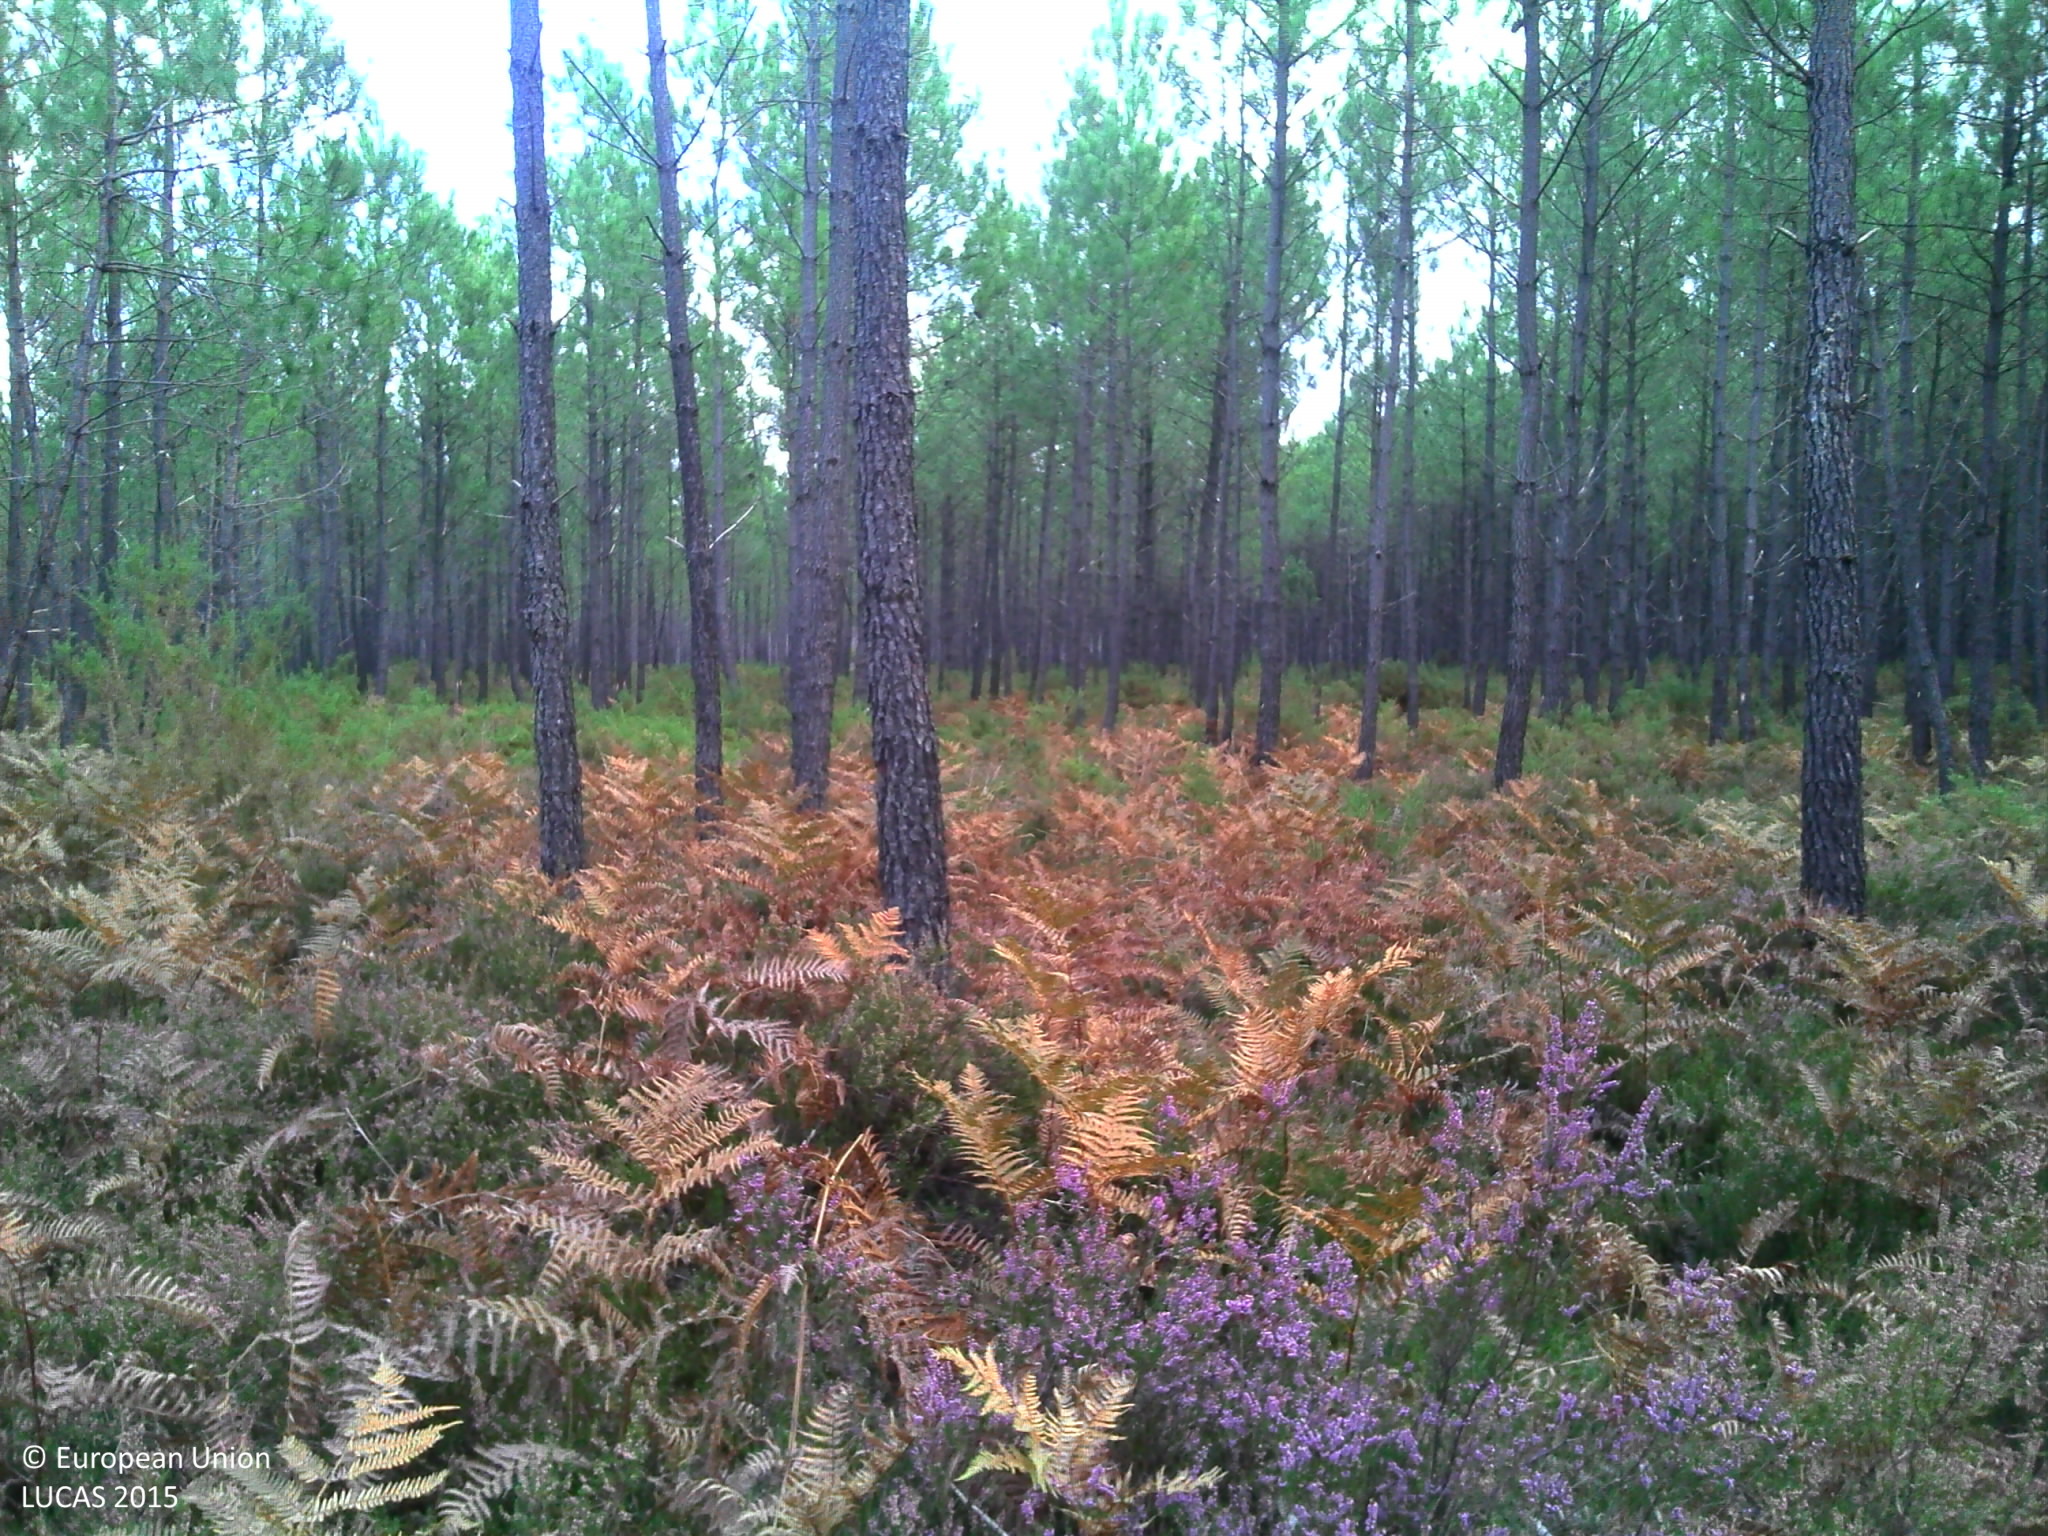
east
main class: Woodland
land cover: Pine dominated coniferous woodland
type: exotic forest
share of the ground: > 75 %
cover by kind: coniferous forest trees 75 %, herbaceous plants 25 %
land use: Forestry
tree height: > 5 m
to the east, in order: Pine dominated coniferous woodland
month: October
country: FR
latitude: 43.9527
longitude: -1.2719
